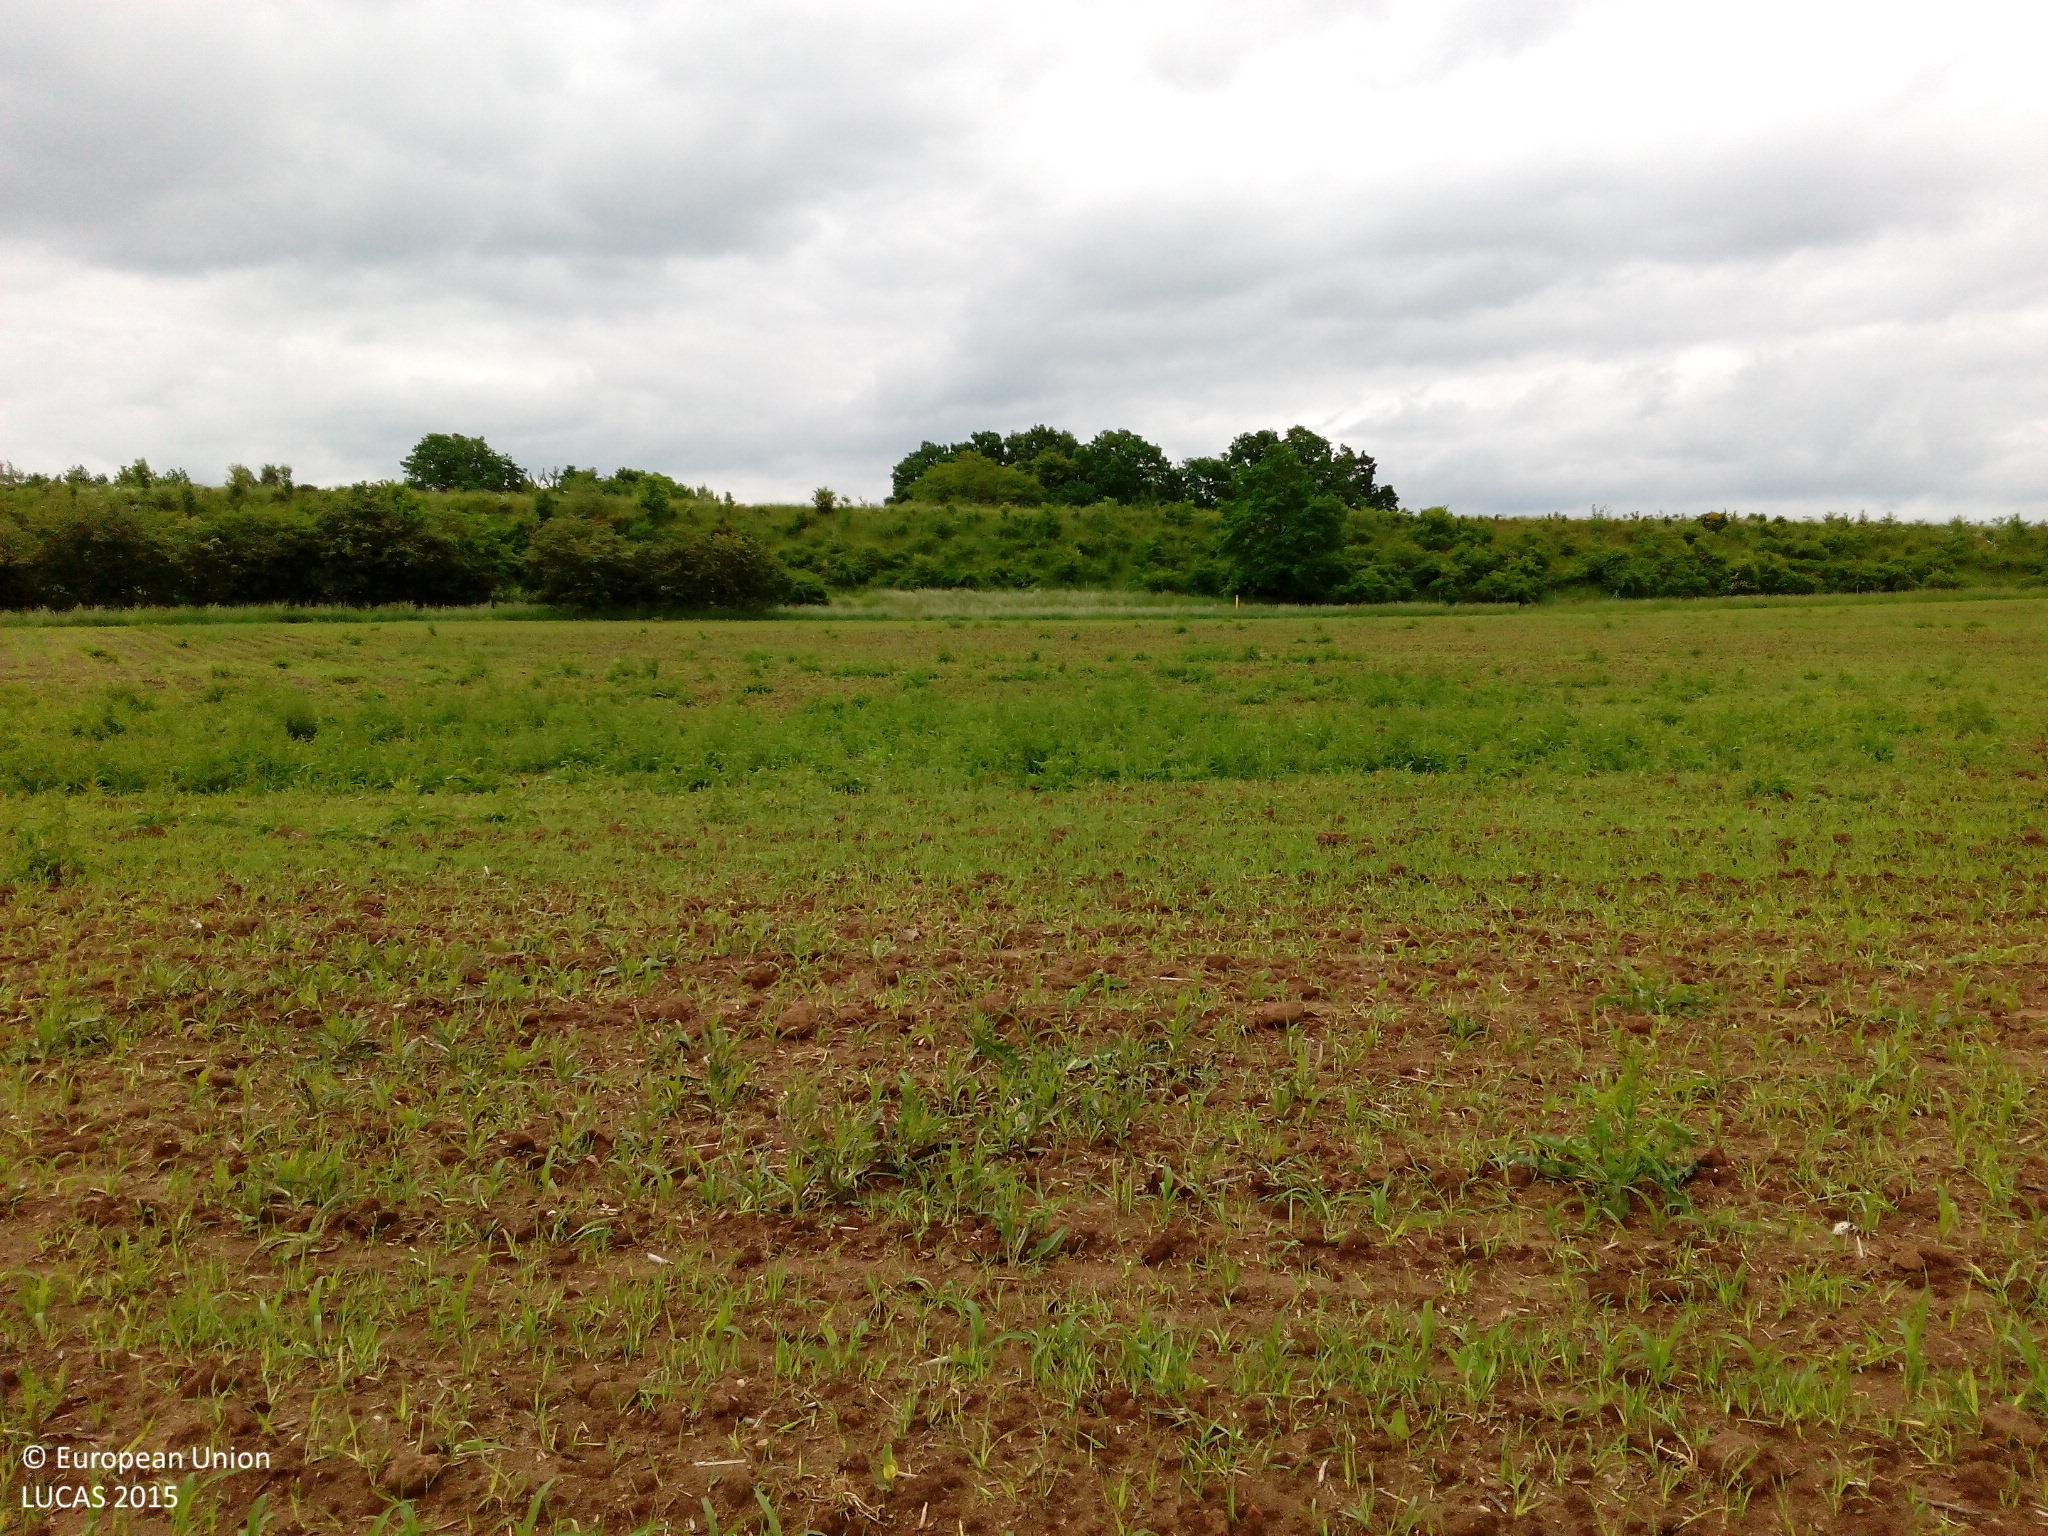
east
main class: Cropland
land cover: Maize
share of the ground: < 10 %
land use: Agriculture (excluding fallow land and kitchen gardens)
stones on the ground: < 10 %
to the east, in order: Maize; Grass margins; Paved roads, cycling and walking lanes; Grassland without tree/shrub cover; Maize; Grass margins; Fences; Shrubland without tree cover; Paved roads, cycling and walking lanes; Grass margins; Fences; Grass margins; Tracks; Grassland without tree/shrub cover; Broadleaved woodland
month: May
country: DE
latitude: 49.9212
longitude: 11.6013
